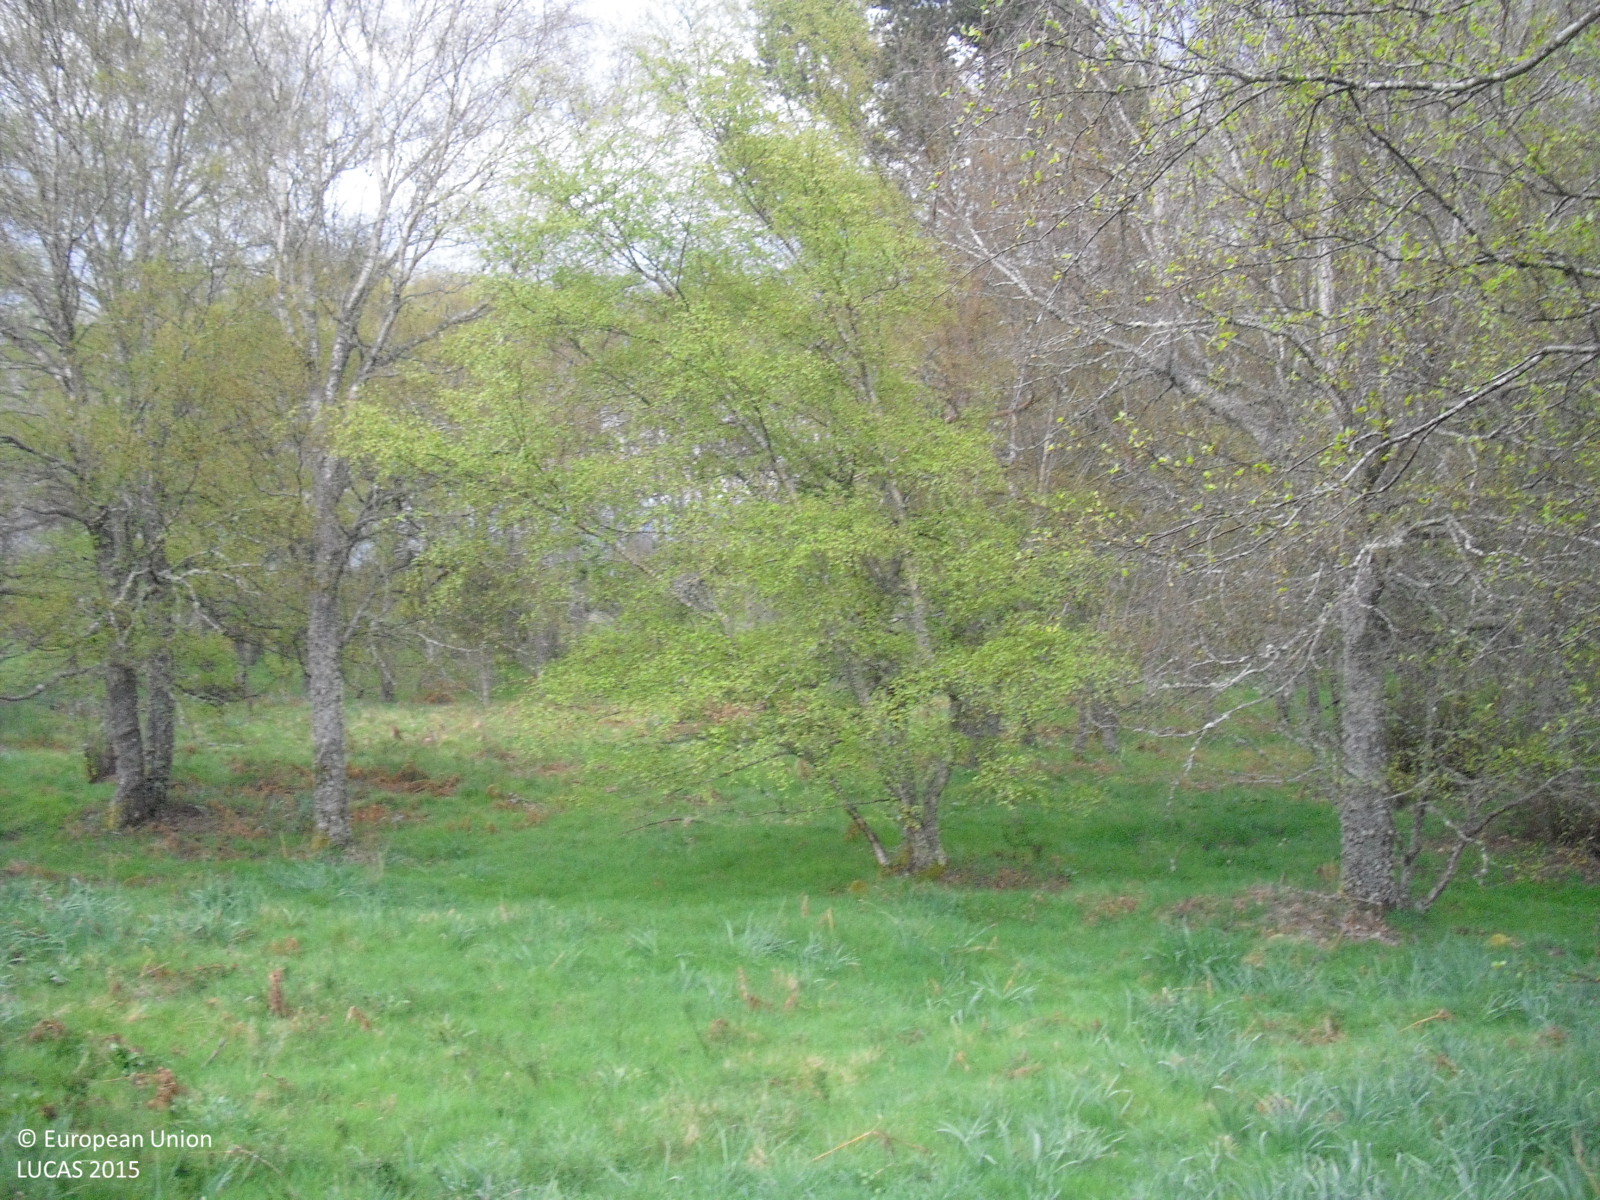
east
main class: Woodland
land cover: Broadleaved woodland
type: beech forest
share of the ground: 25 - 50 %
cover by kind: herbaceous plants 50 %, broadleaved forest trees 30 %, shrubs 20 %
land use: Forestry
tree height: > 5 m
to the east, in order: Broadleaved woodland; Grassland without tree/shrub cover; Broadleaved woodland; Grassland with sparse tree/shrub cover; Ditches and canals; Grass margins; Tracks; Shruby margins; Ditches and canals; Shrubland without tree cover; Pine dominated coniferous woodland
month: April
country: ES
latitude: 41.9139
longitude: -7.6807
